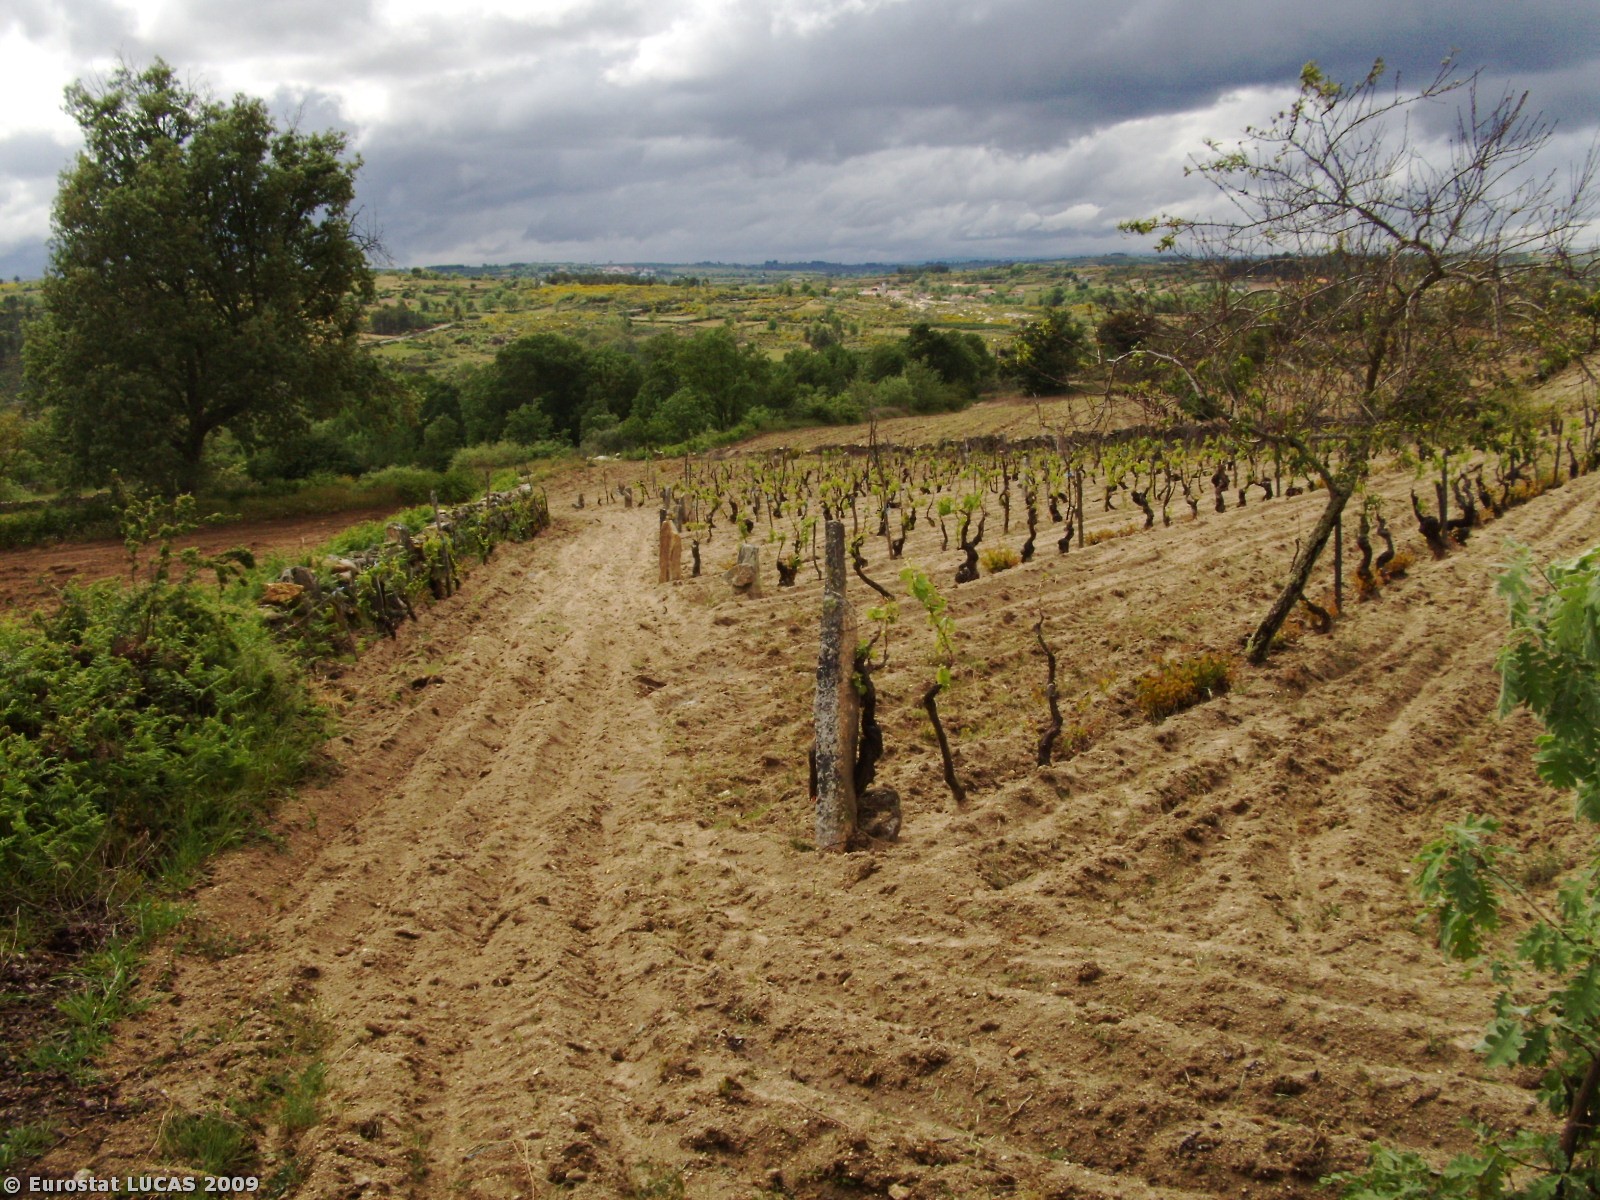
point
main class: Cropland
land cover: Vineyards
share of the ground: 10 - 25 %
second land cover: Bare land
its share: > 75 %
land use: Agriculture (excluding fallow land and kitchen gardens)
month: May
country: PT
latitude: 40.6746
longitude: -7.0803
